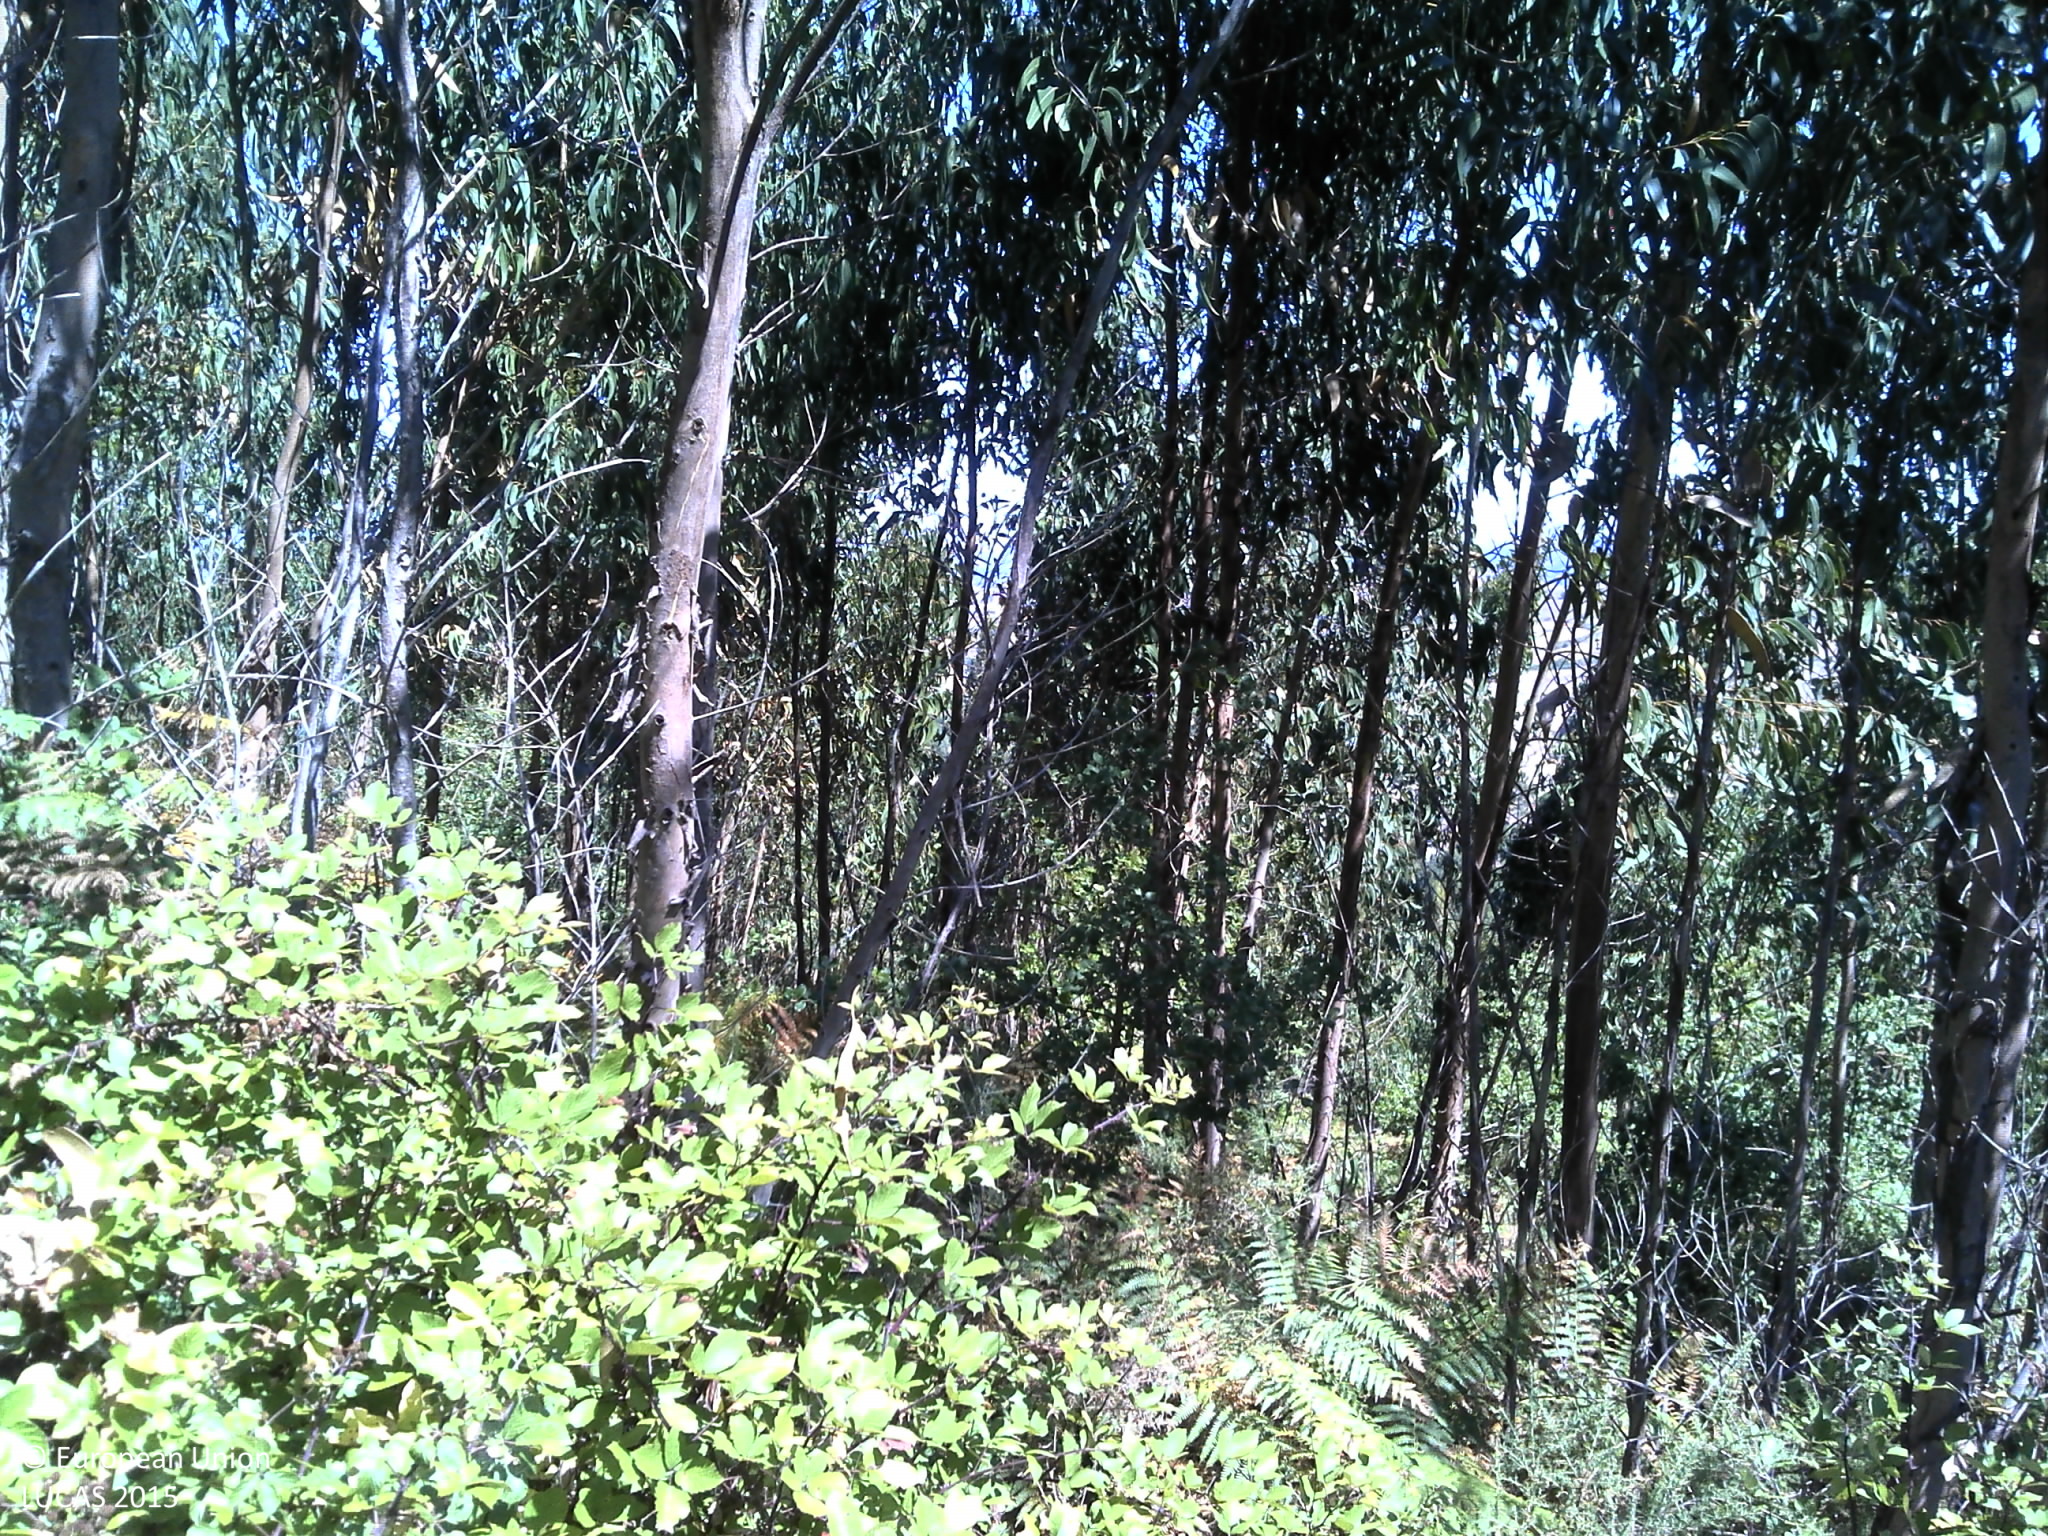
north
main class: Woodland
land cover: Broadleaved woodland
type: exotic forest
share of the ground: 50 - 75 %
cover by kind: broadleaved forest trees 55 %, shrubs 30 %, unconsolidated bare surface 15 %
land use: Forestry
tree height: > 5 m
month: July
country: PT
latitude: 38.9524
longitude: -9.2494
